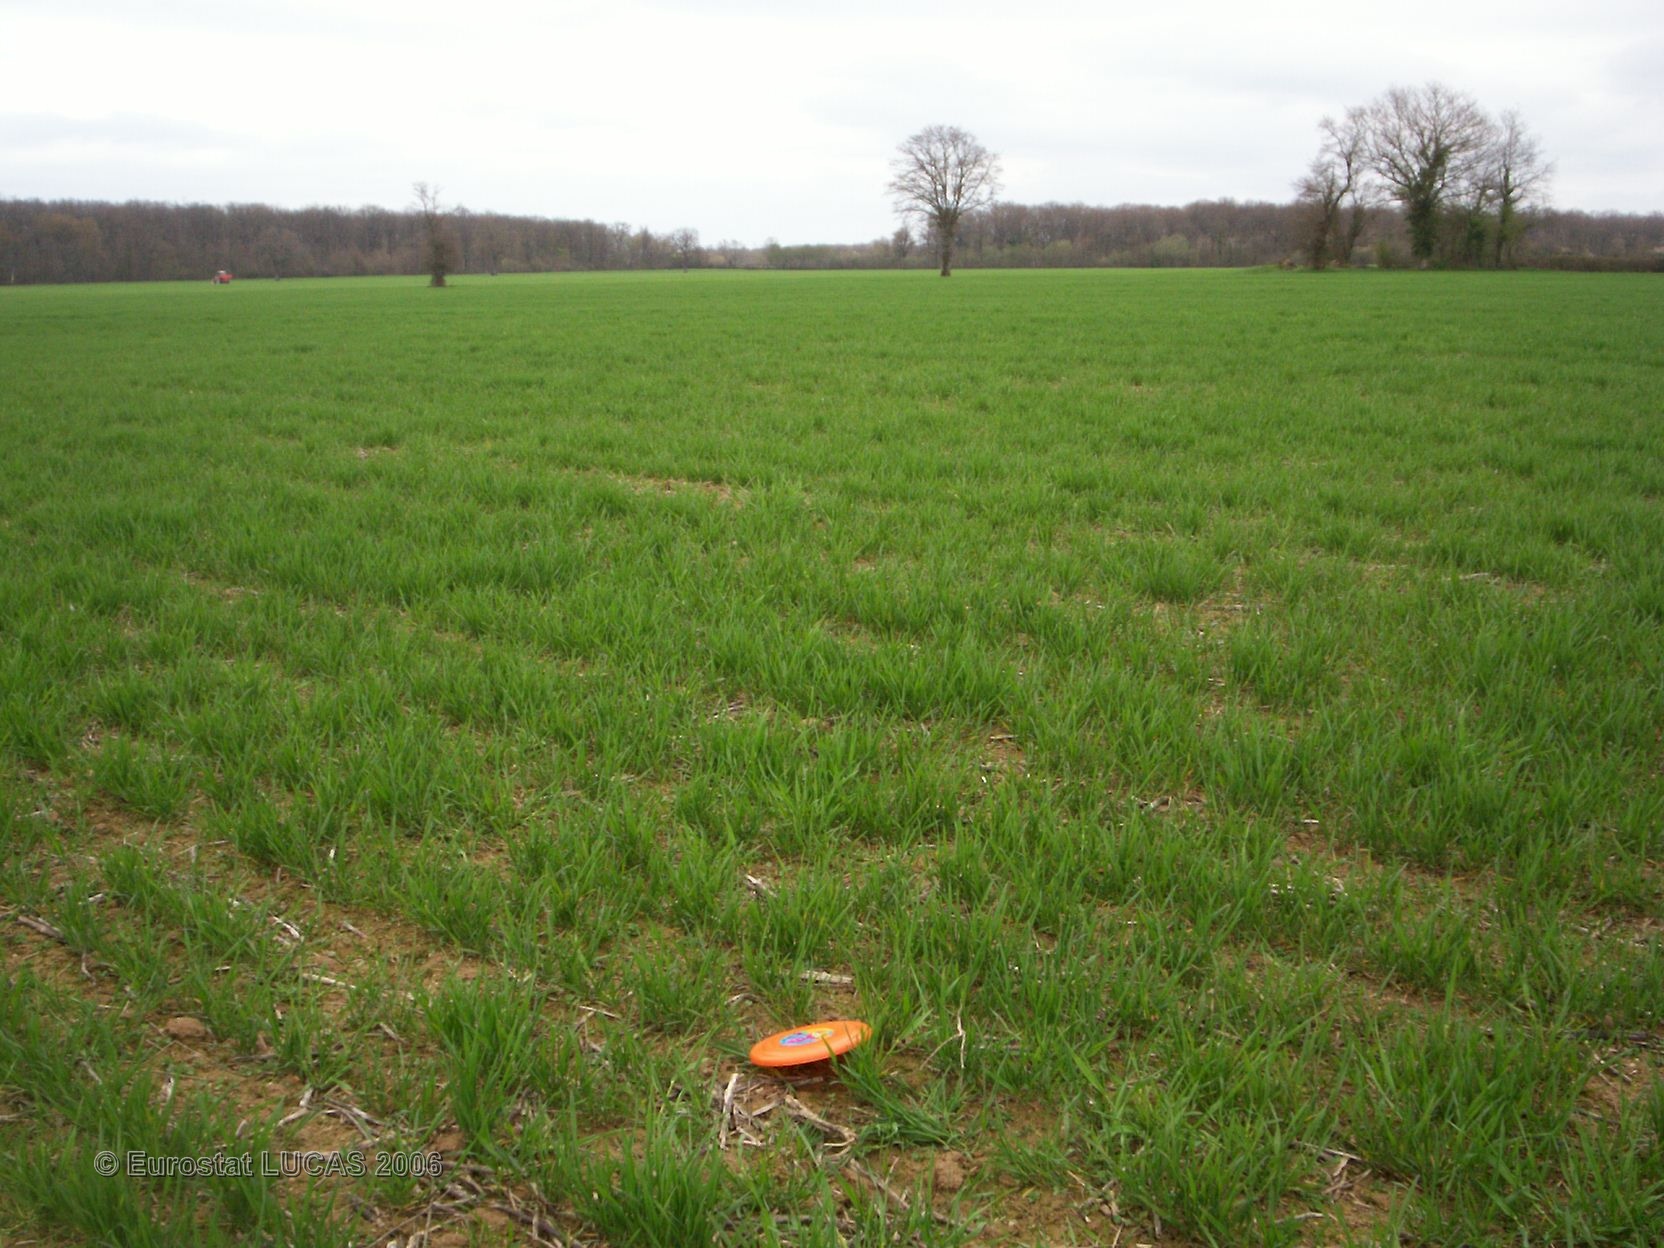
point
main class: Cropland
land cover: Common wheat
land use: Agriculture (excluding fallow land and kitchen gardens)
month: April
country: FR
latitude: 46.7214
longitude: 3.0494
